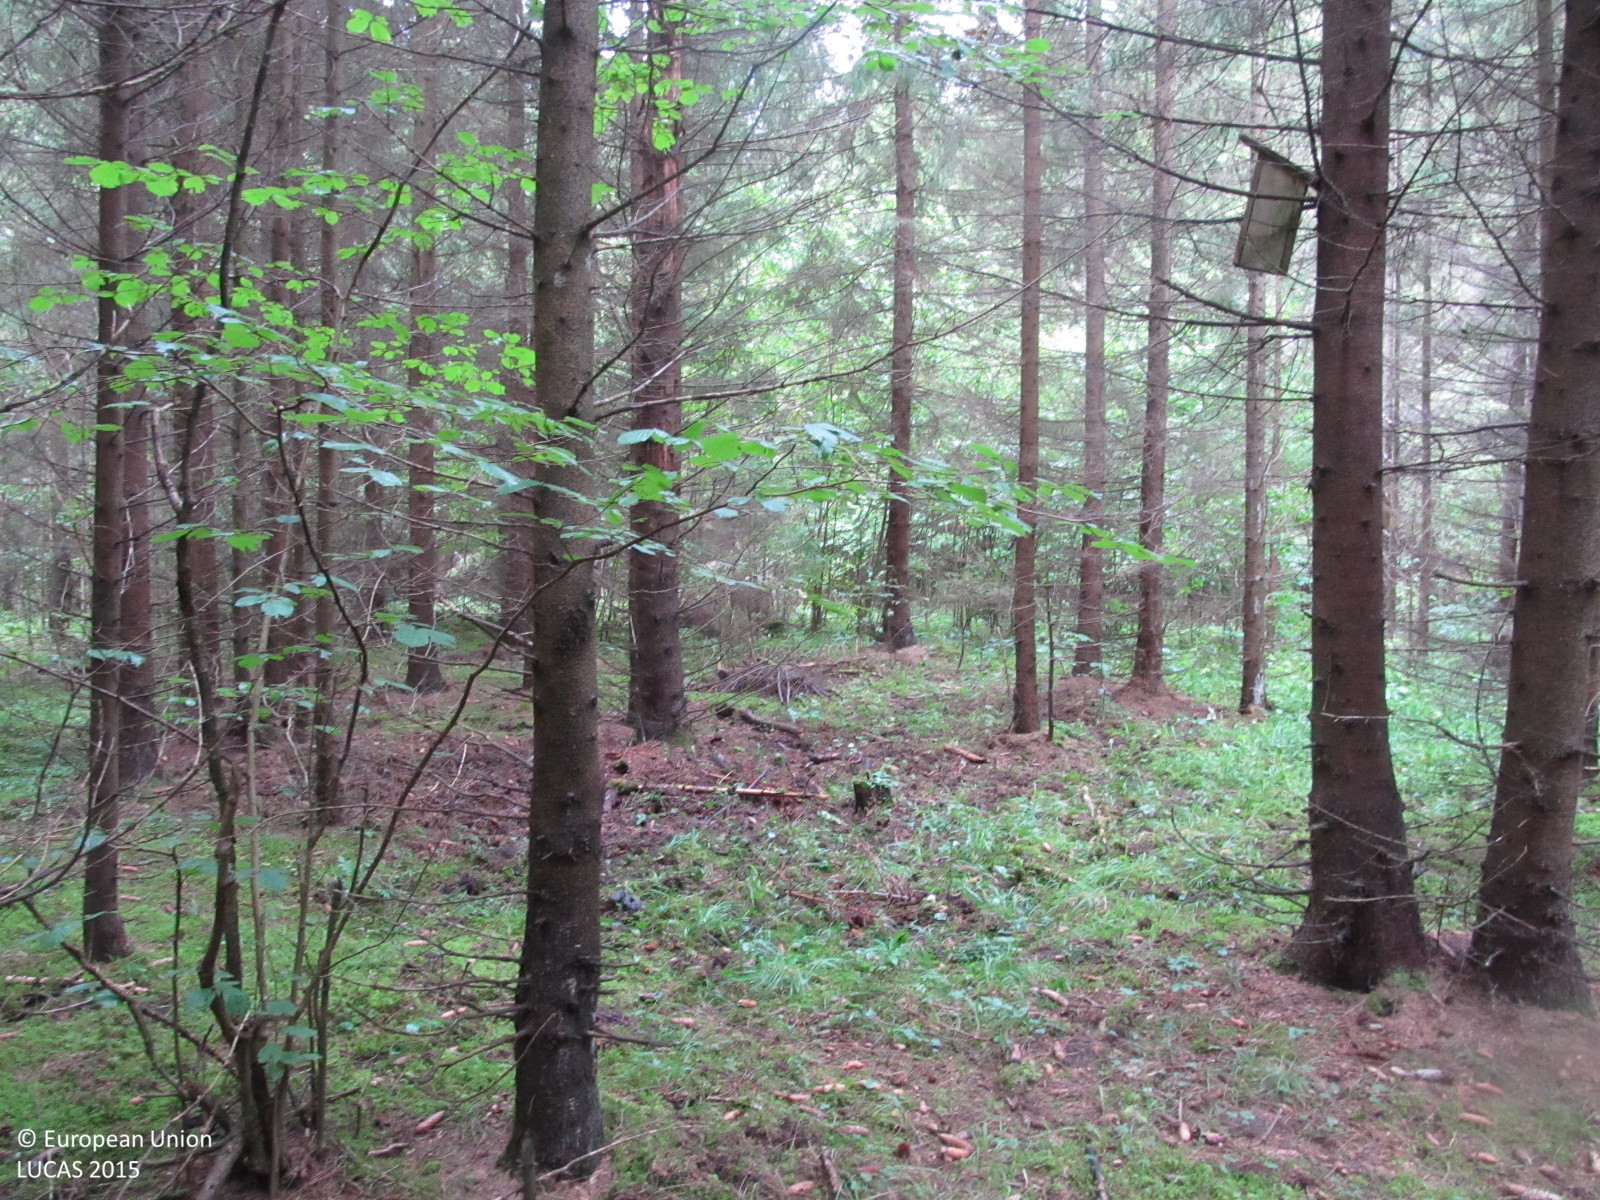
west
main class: Woodland
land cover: Spruce dominated coniferous woodland
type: hemiboreal forest and nemoral coniferous forest and mixed broadleaved-coniferous forest
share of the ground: > 75 %
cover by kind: coniferous forest trees 80 %, lichens and mosses 15 %, herbaceous plants 5 %
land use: Forestry
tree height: > 5 m
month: September
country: LT
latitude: 56.0648
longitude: 23.2262
